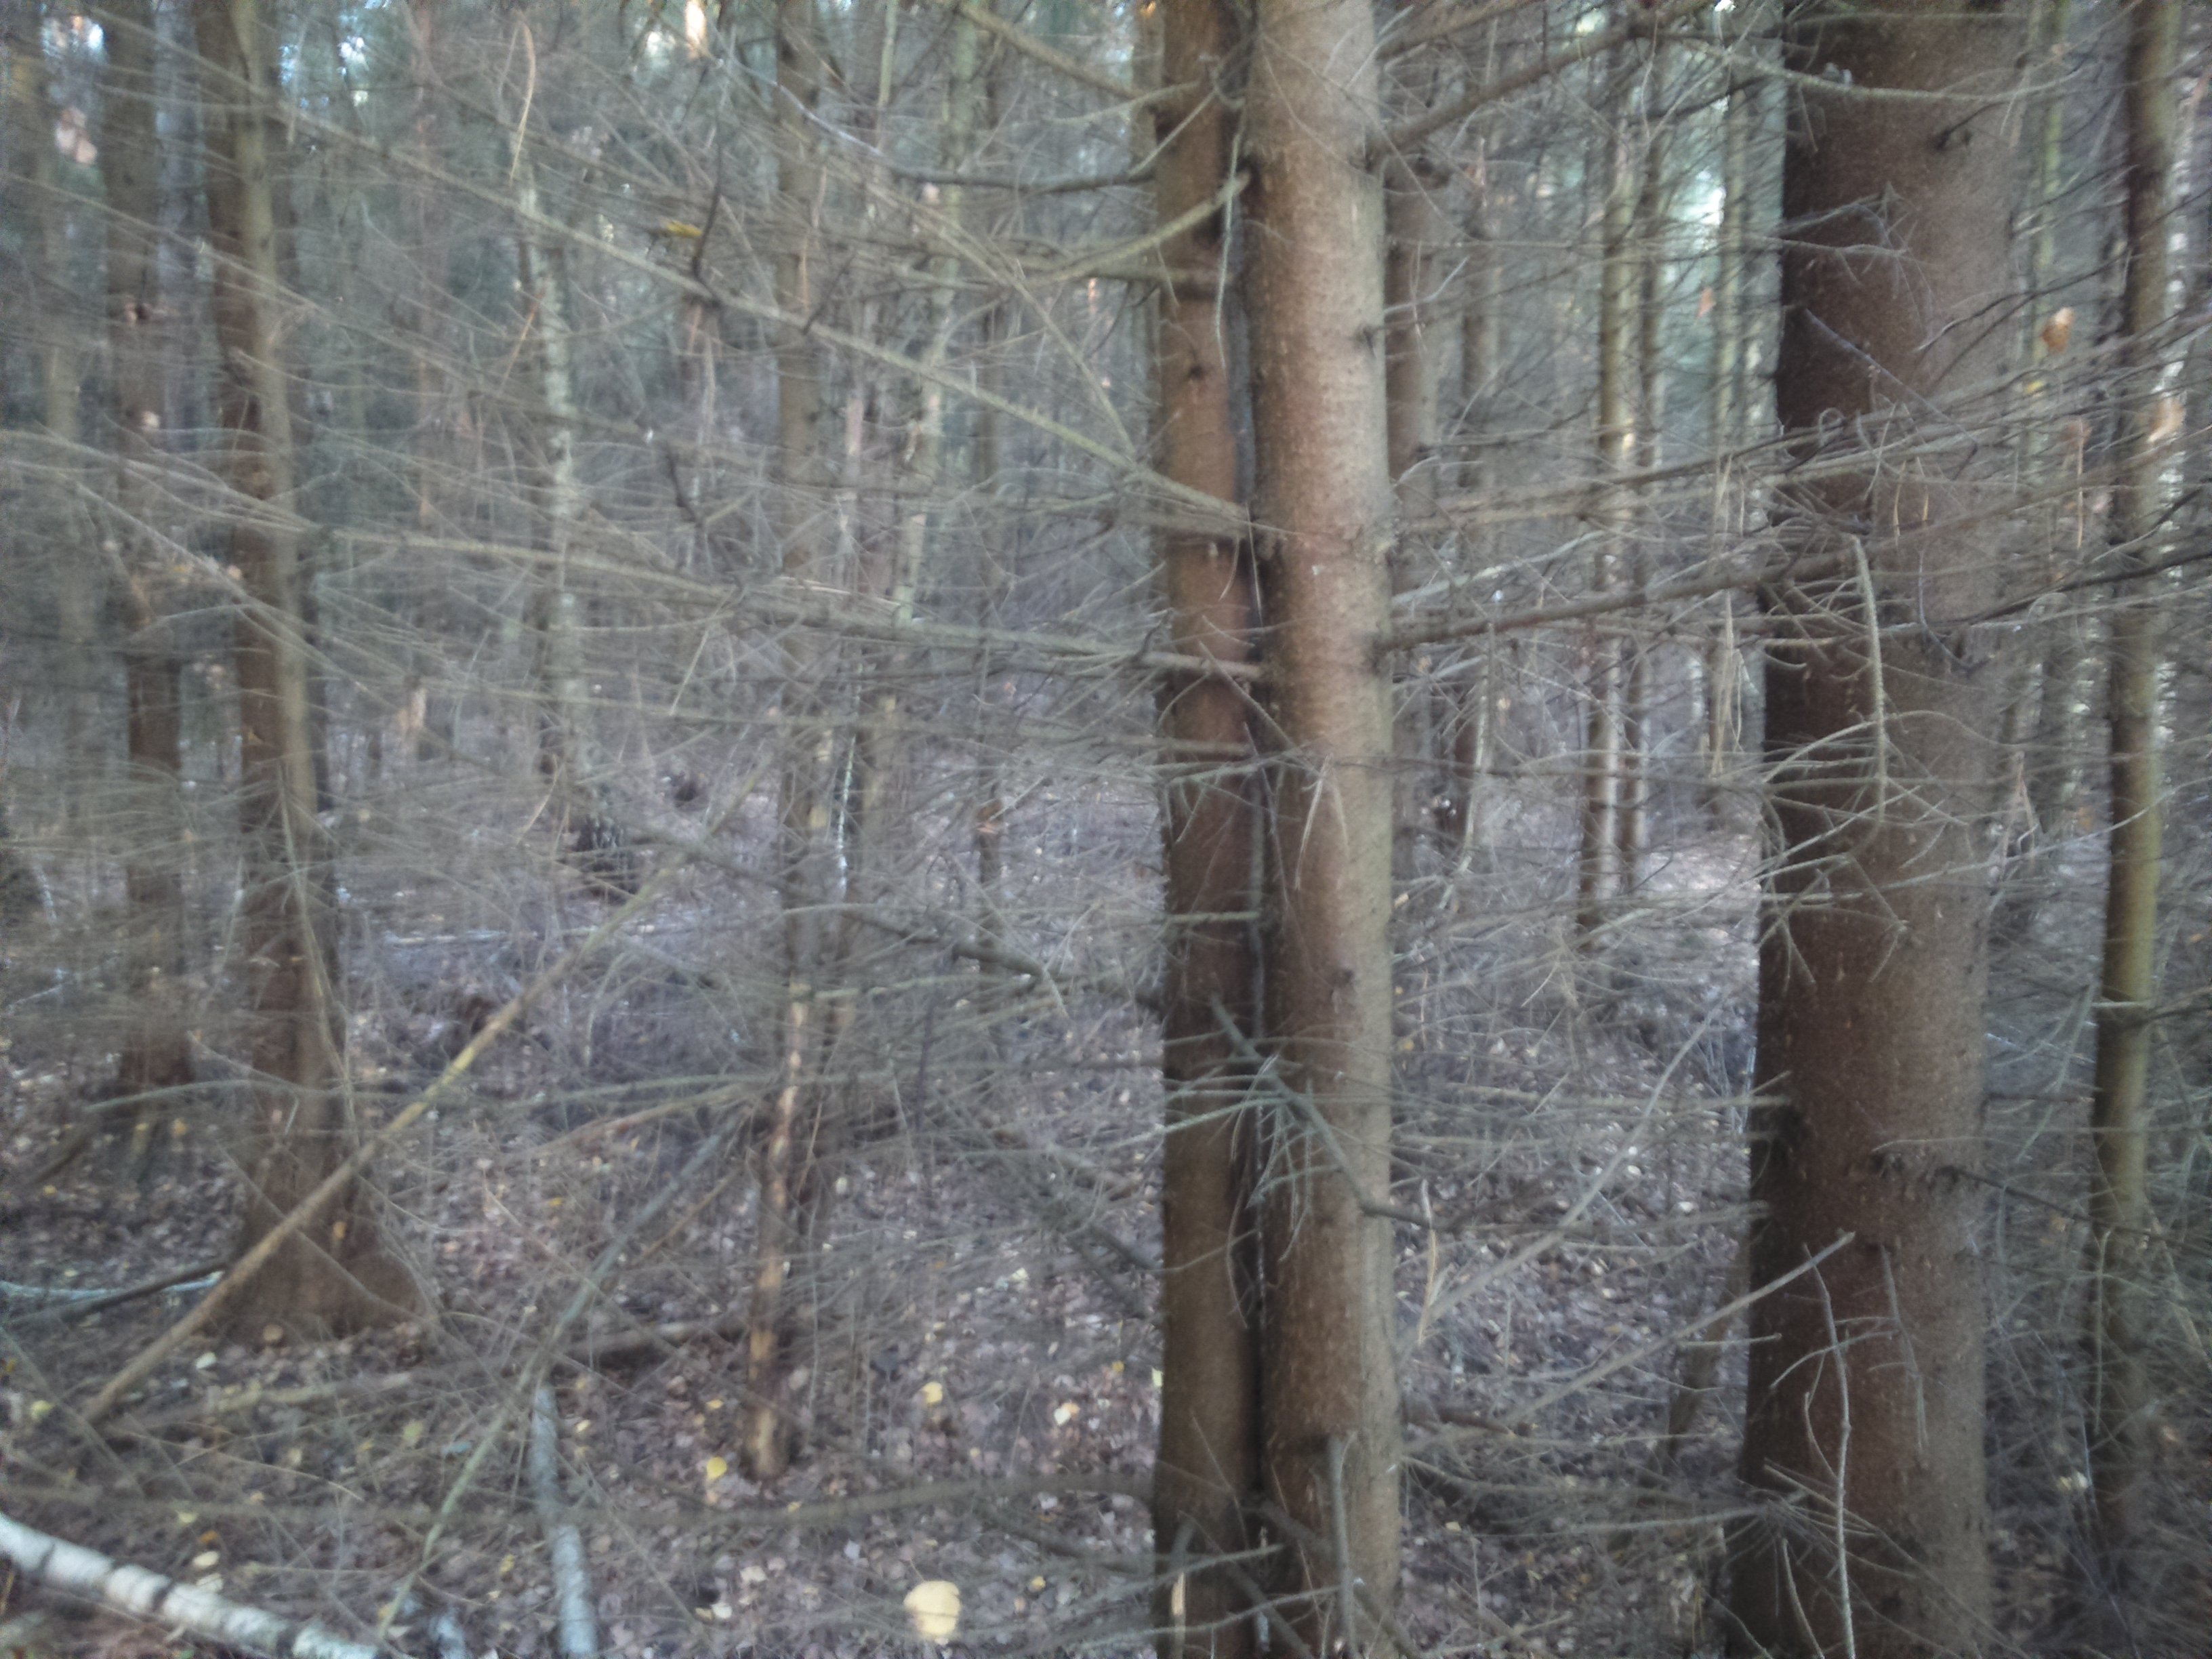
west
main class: Woodland
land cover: Spruce dominated mixed woodland
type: hemiboreal forest and nemoral coniferous forest and mixed broadleaved-coniferous forest
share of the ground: > 75 %
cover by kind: coniferous forest trees 75 %, broadleaved forest trees 25 %
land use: Forestry
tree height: > 5 m
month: September
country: PL
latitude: 52.5166
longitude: 22.1293
